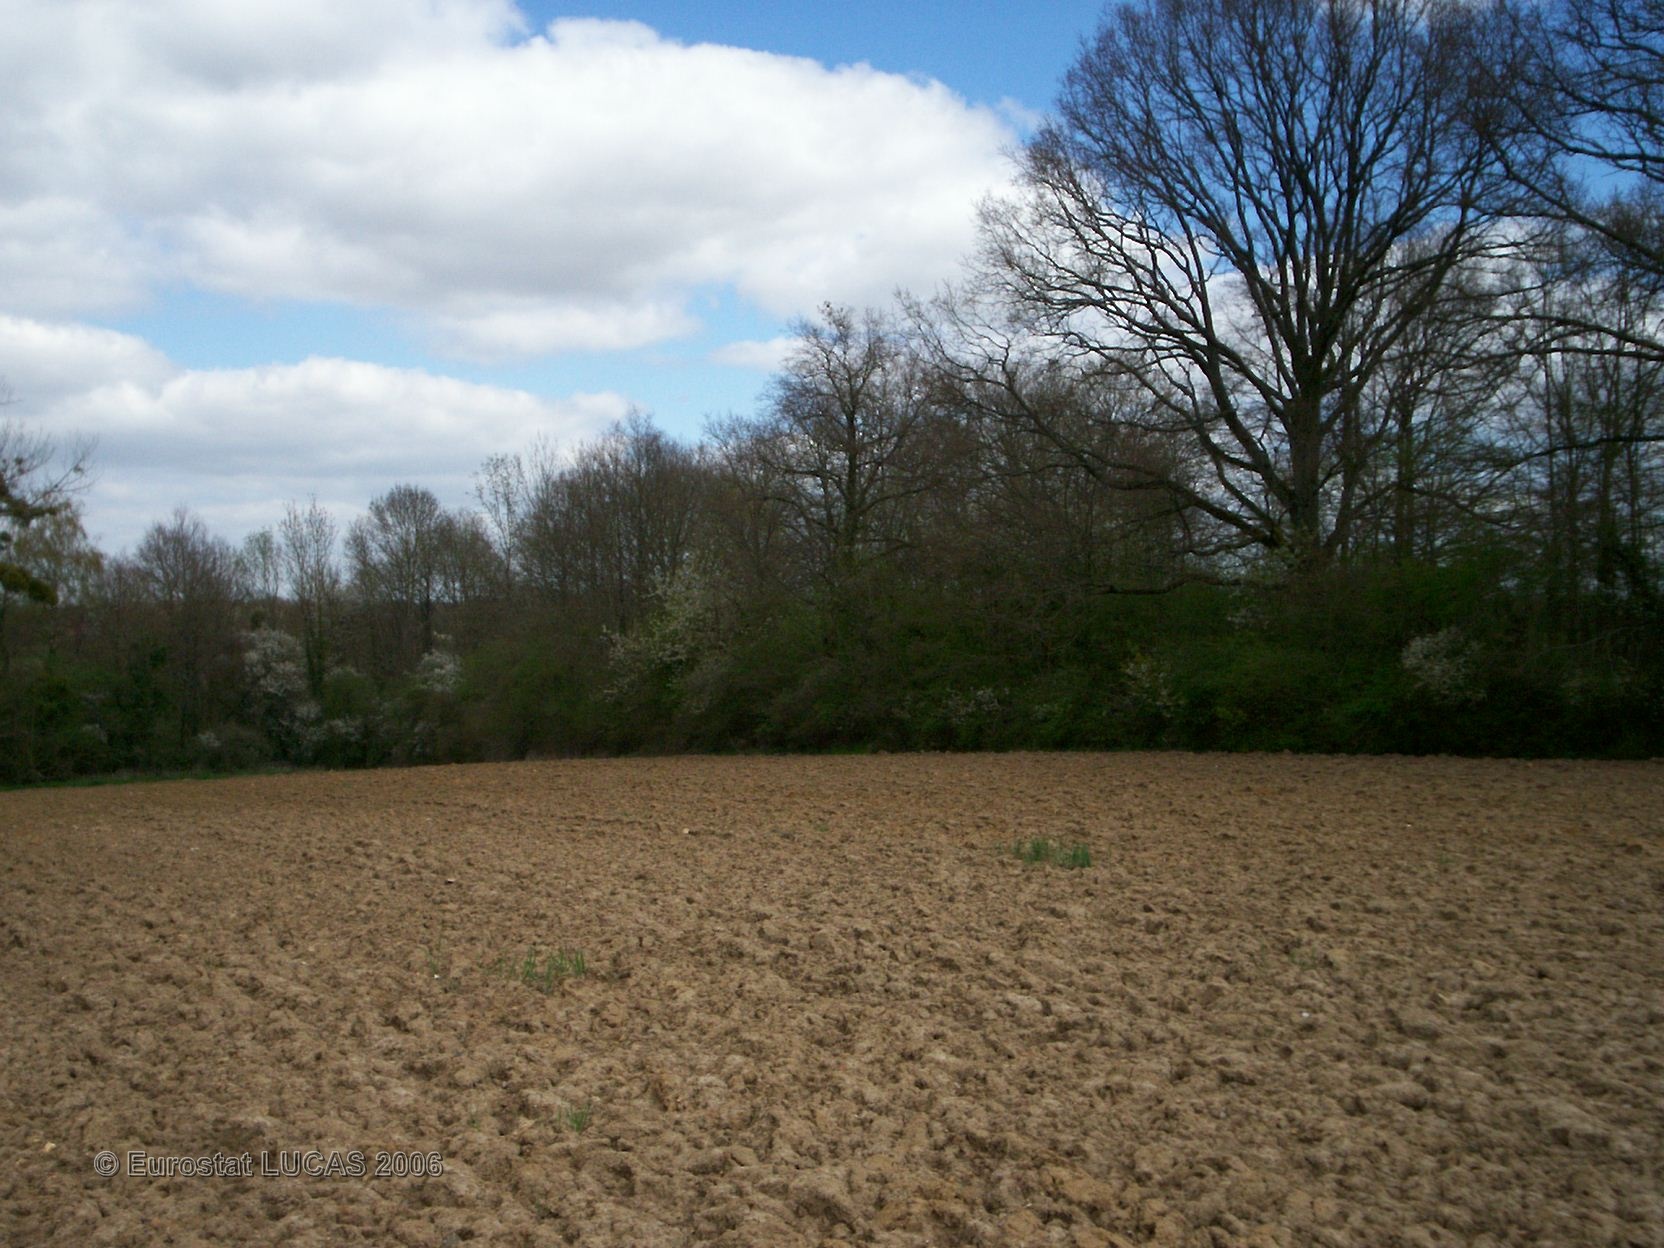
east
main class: Cropland
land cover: Maize
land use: Agriculture (excluding fallow land and kitchen gardens)
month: May
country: FR
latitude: 48.5530
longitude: 2.8786
